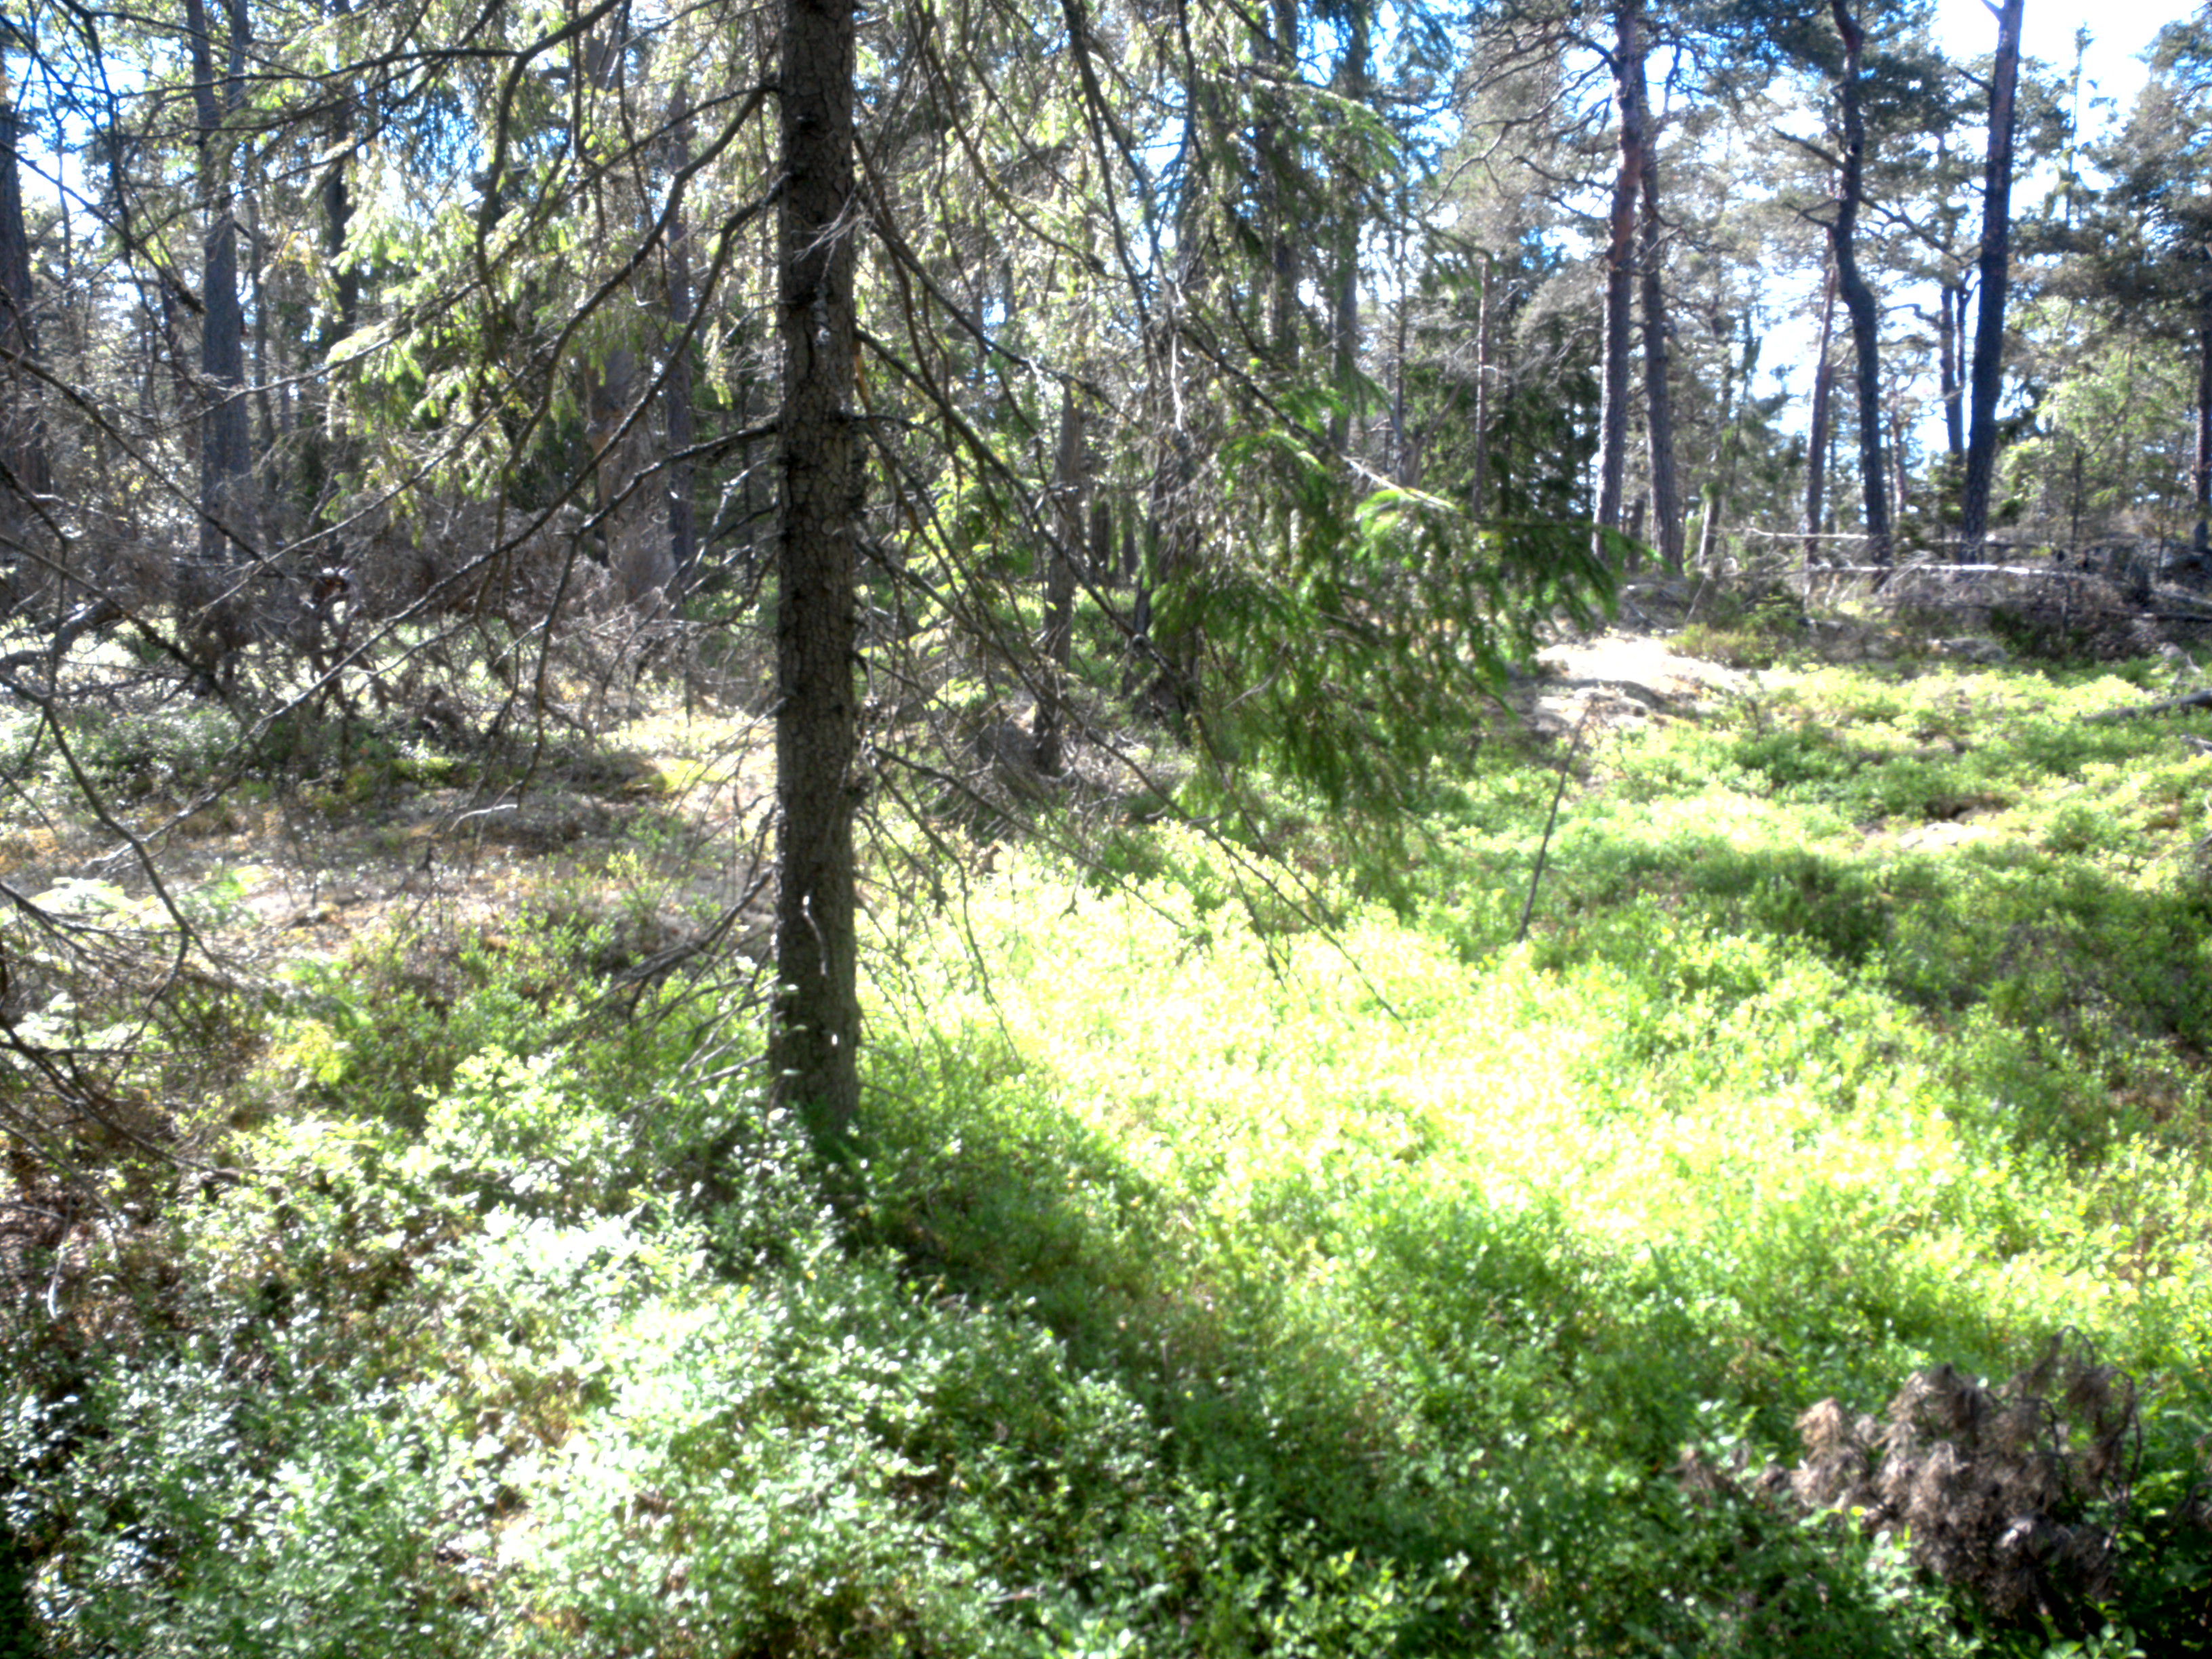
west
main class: Woodland
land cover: Pine dominated coniferous woodland
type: boreal forest
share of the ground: 25 - 50 %
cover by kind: coniferous forest trees 50 %, shrubs 45 %, lichens and mosses 5 %
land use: Amenities, museums, leisure
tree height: > 5 m
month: June
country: SE
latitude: 59.1788
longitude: 18.2419
